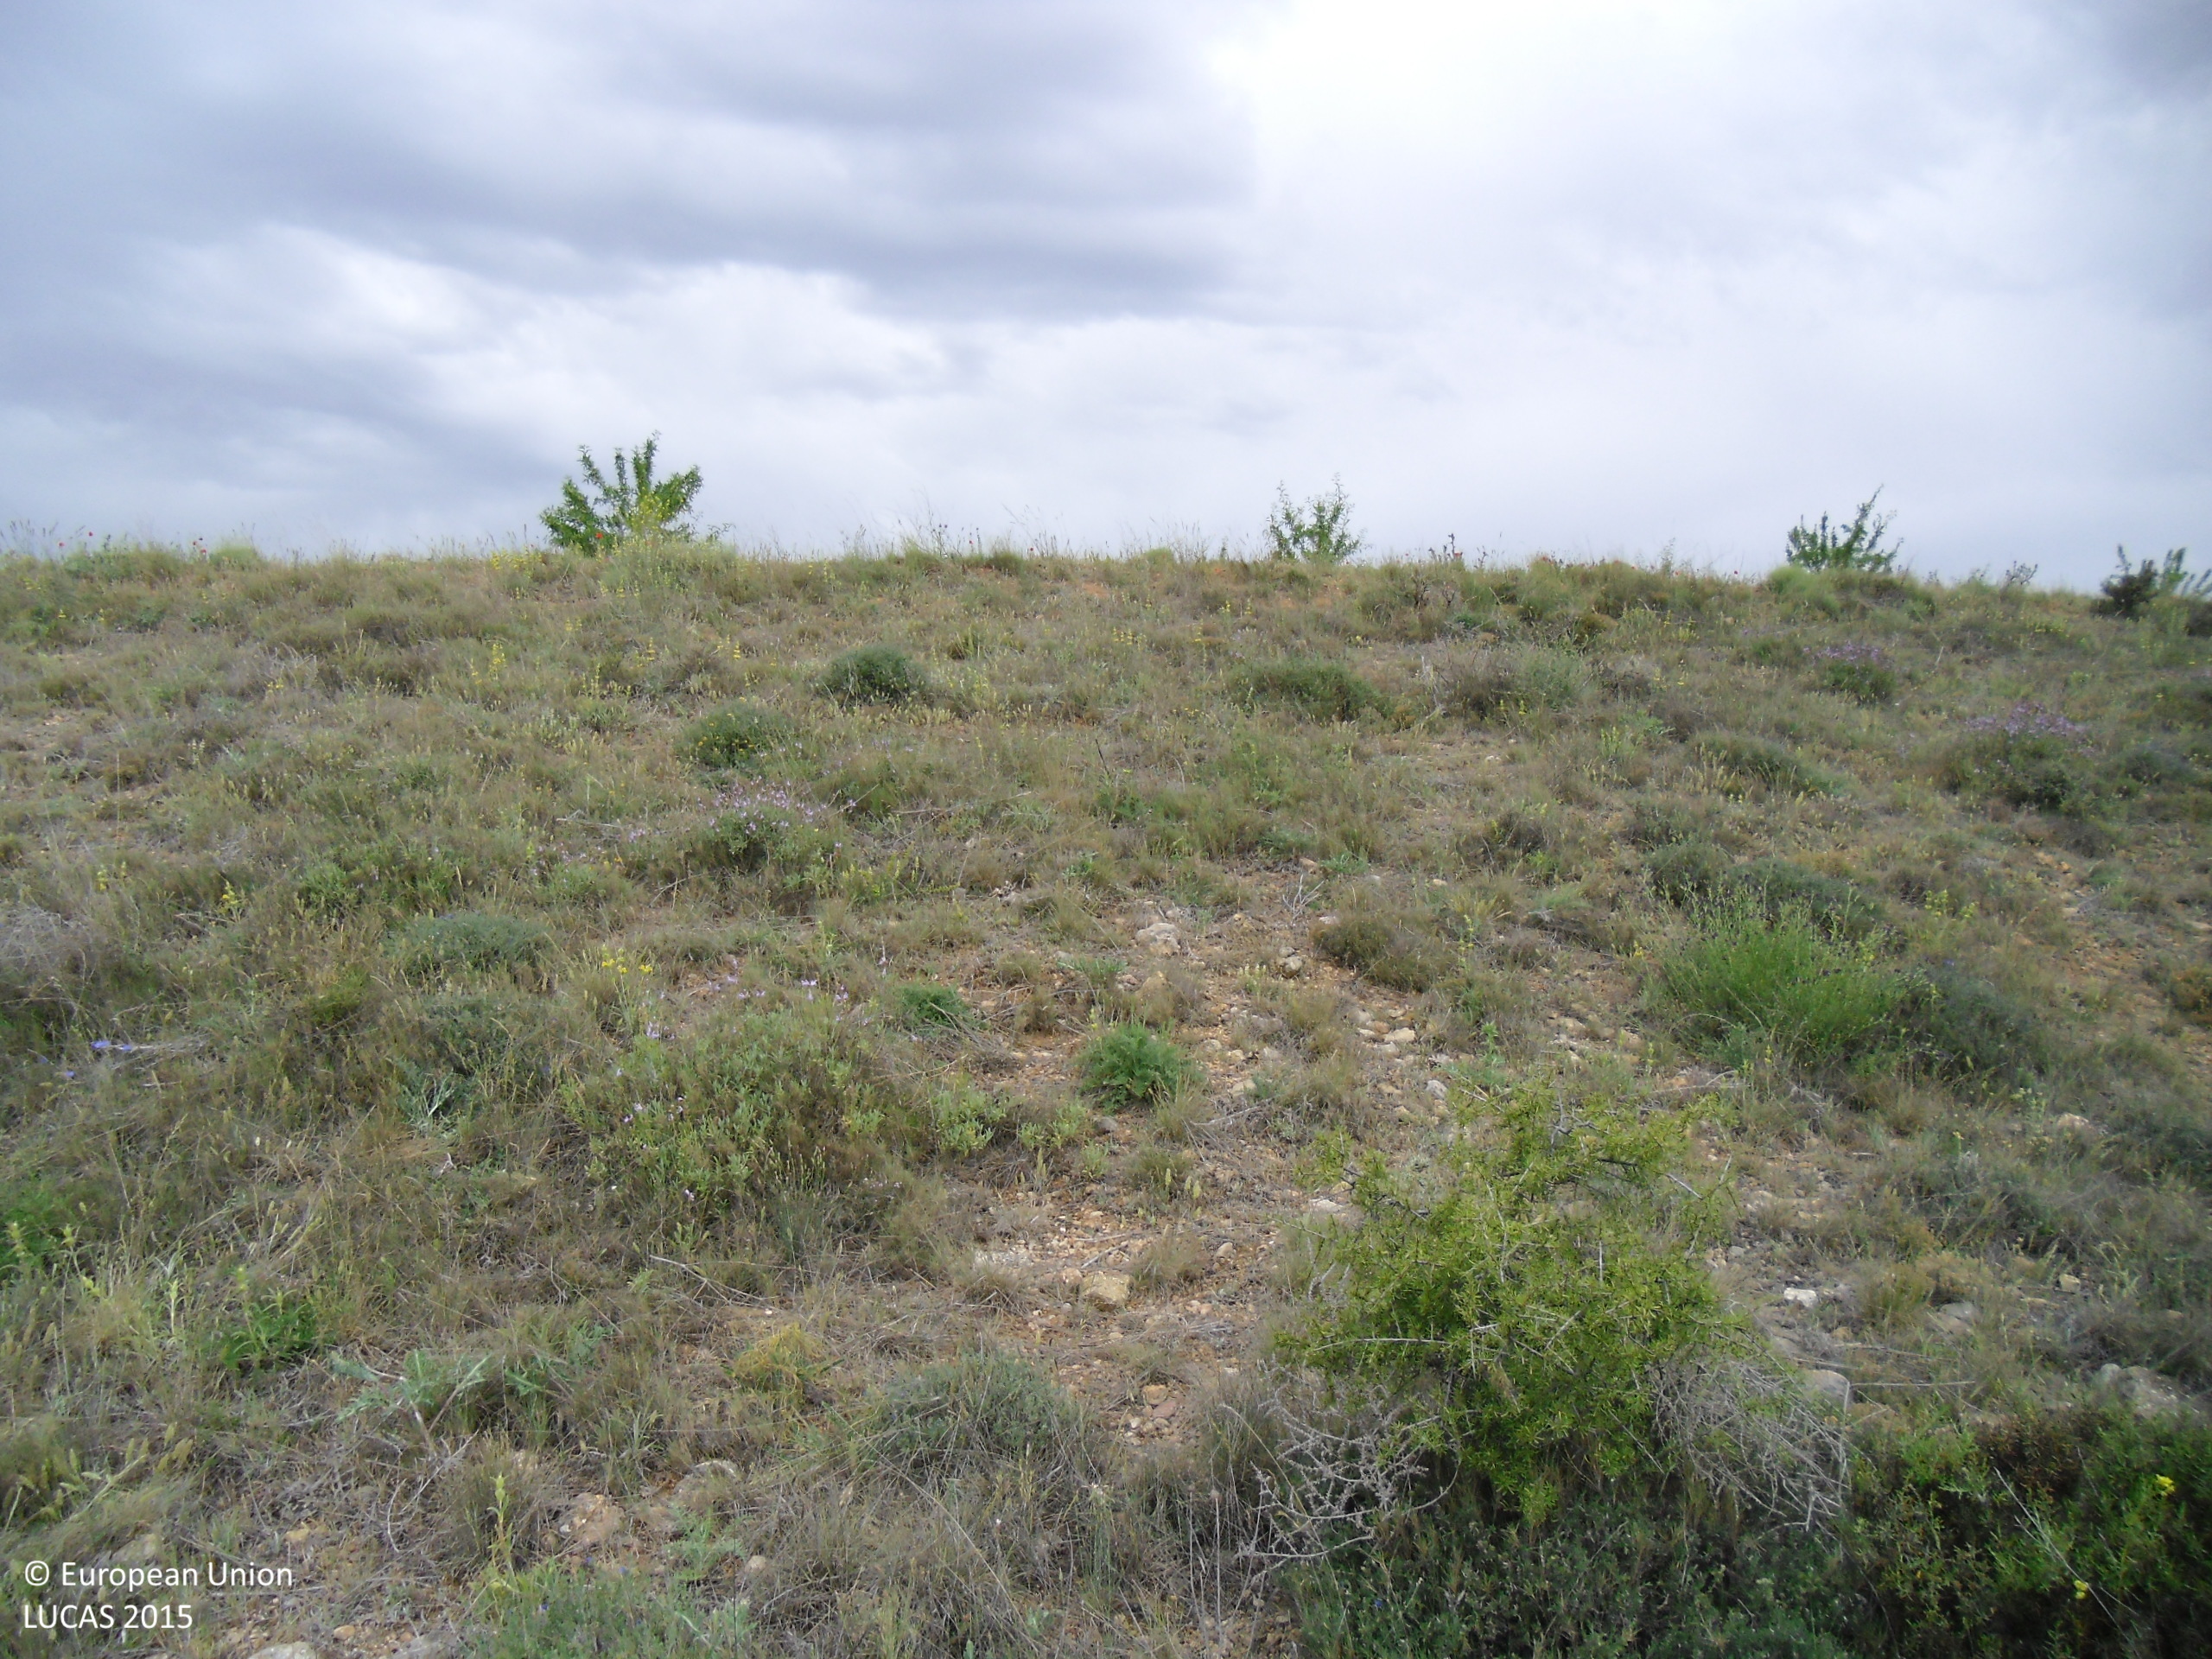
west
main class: Shrubland
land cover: Shrubland without tree cover
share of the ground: 50 - 75 %
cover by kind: shrubs 60 %, herbaceous plants 20 %, unconsolidated bare surface 20 %
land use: Agriculture (excluding fallow land and kitchen gardens)
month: May
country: ES
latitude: 41.0106
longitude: -0.8716
